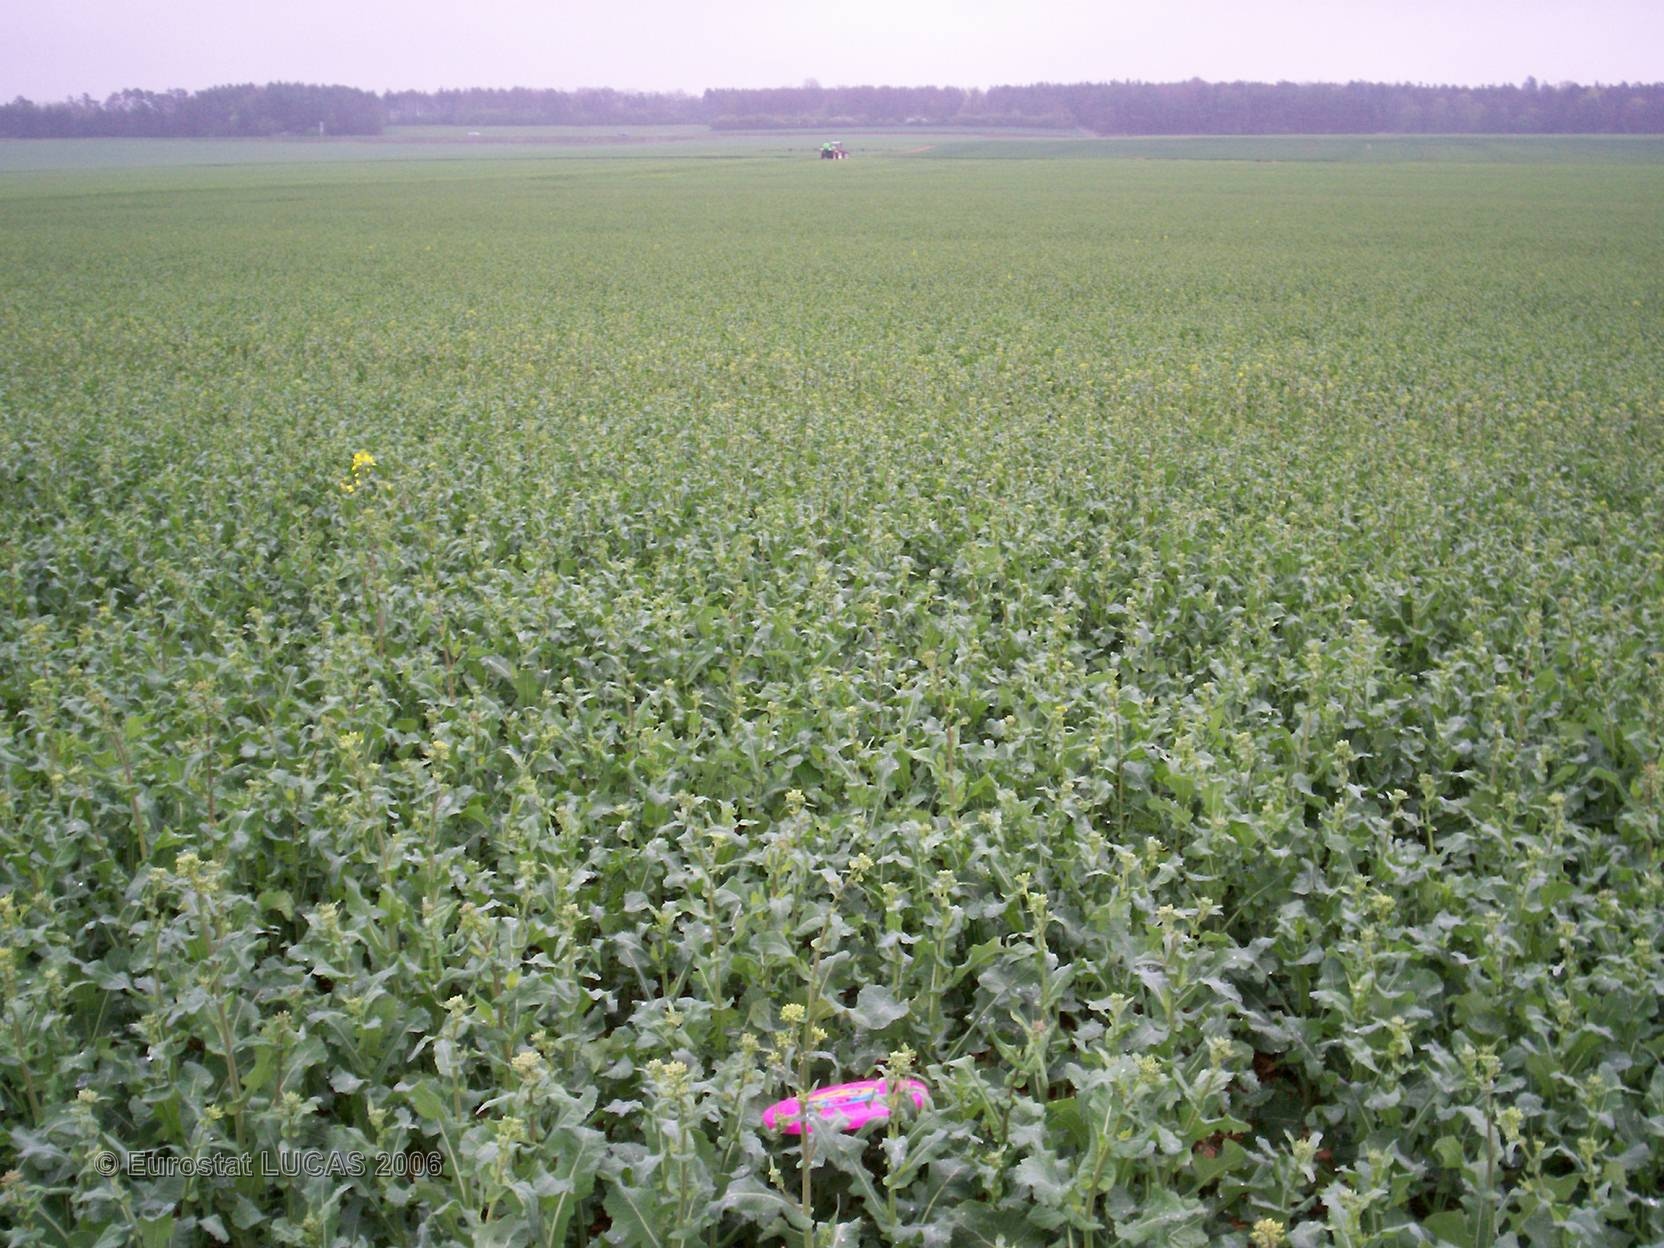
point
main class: Cropland
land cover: Rape and turnip rape
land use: Agriculture (excluding fallow land and kitchen gardens)
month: April
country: FR
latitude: 47.7983
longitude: 4.5113
